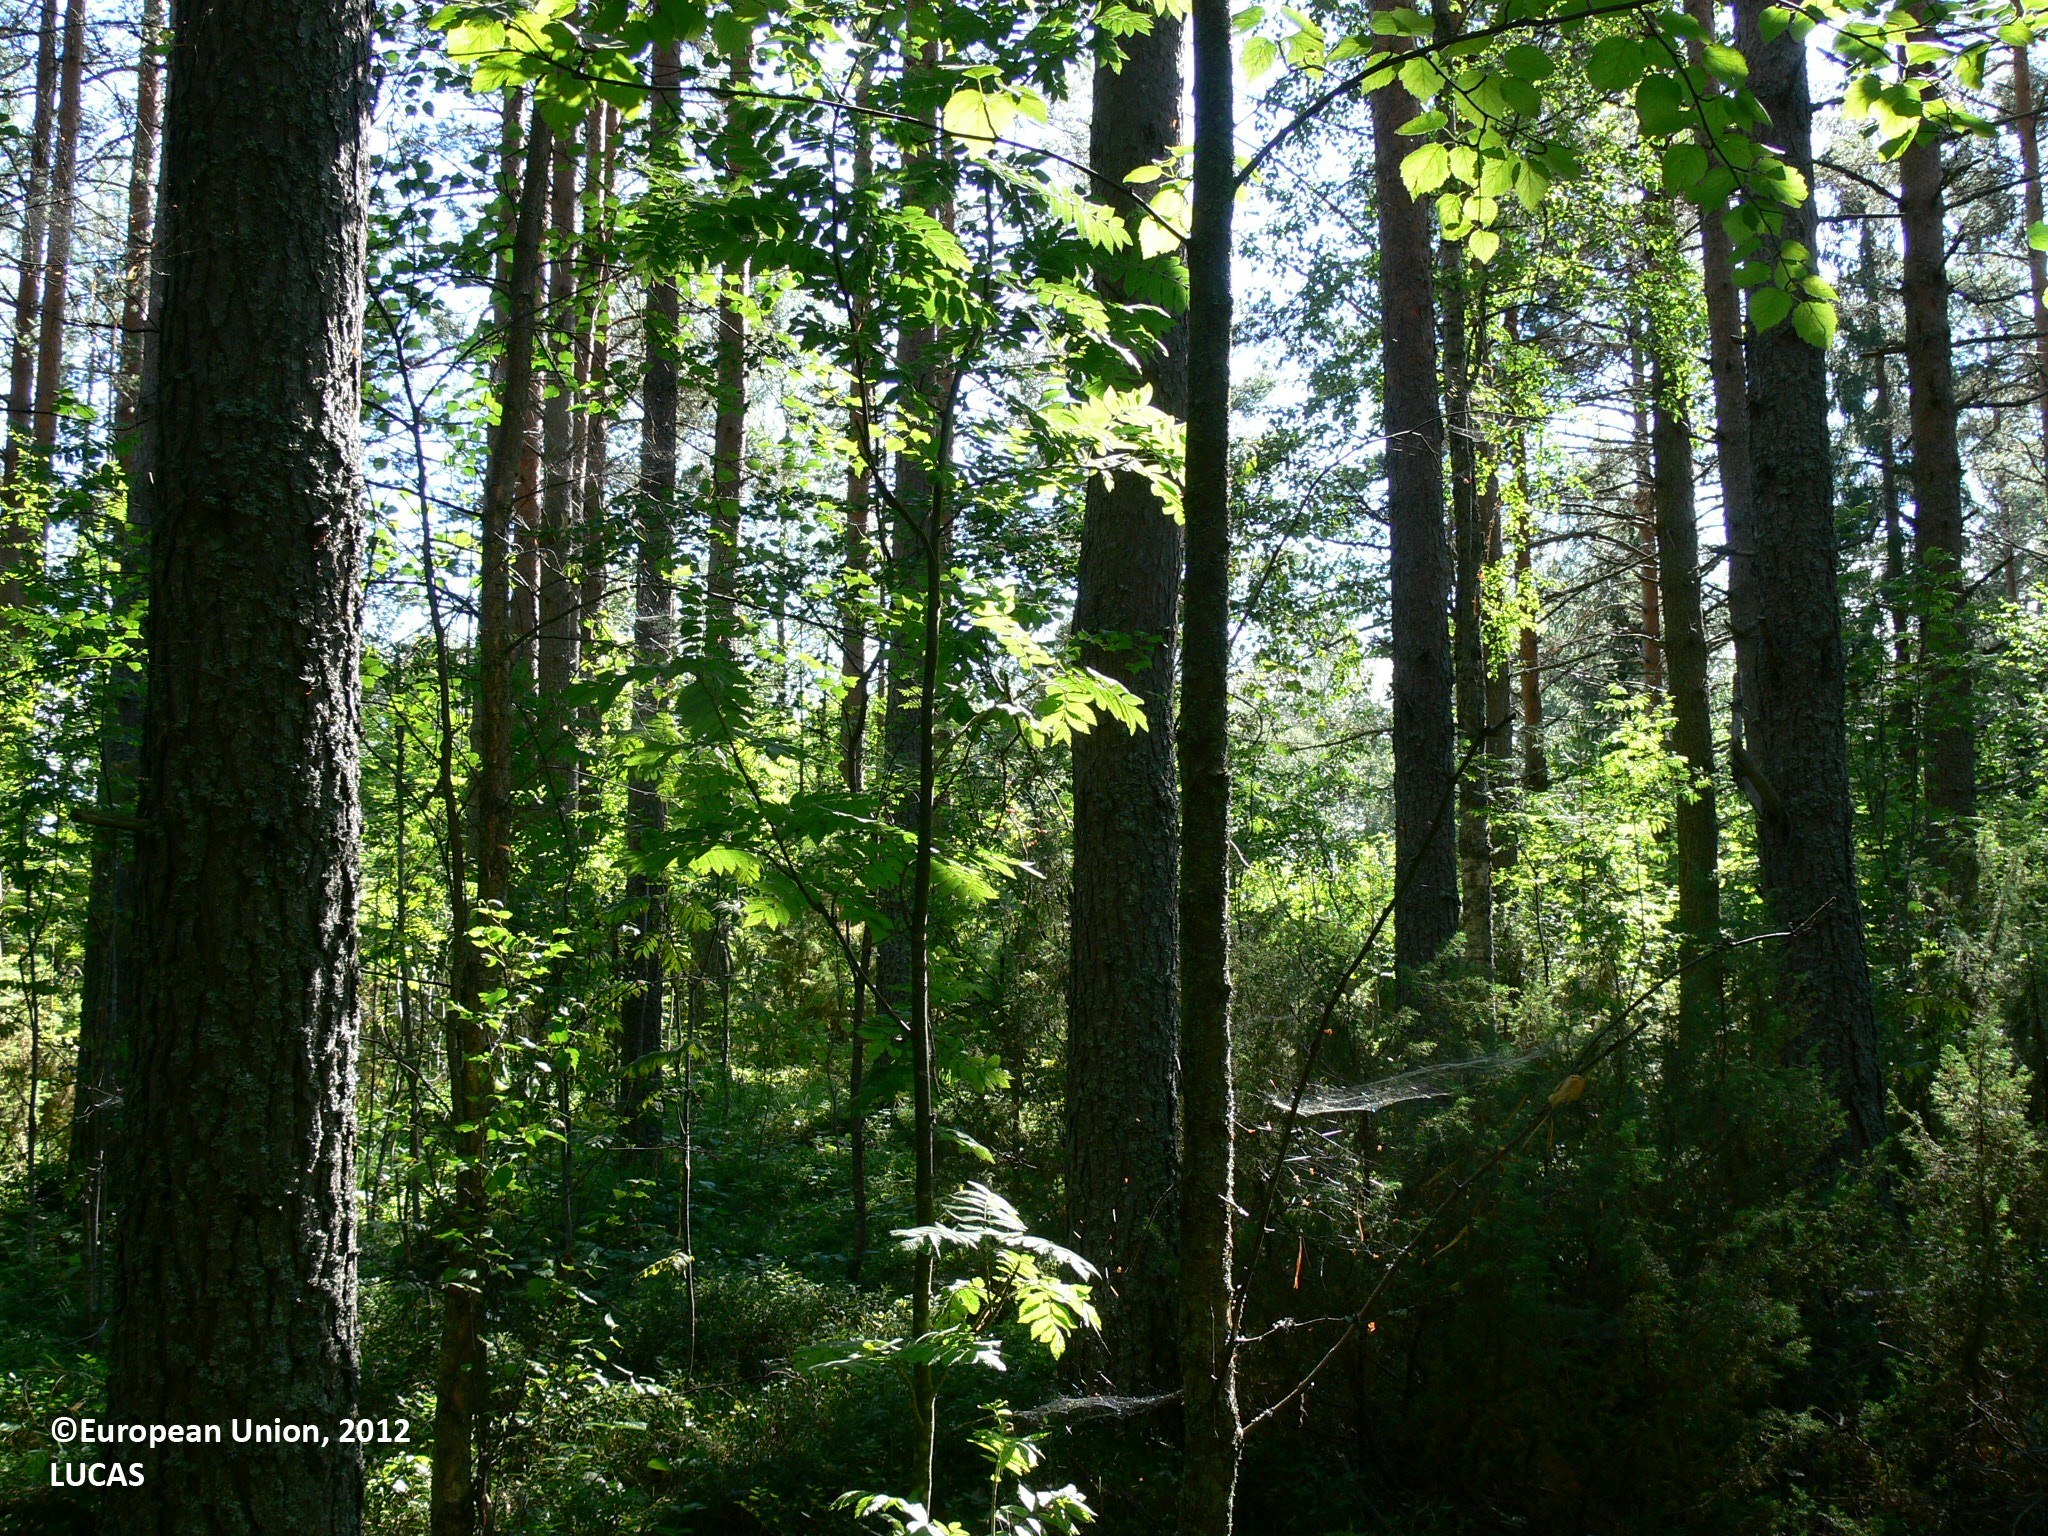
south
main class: Woodland
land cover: Pine dominated mixed woodland
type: boreal forest
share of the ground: > 75 %
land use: Forestry
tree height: > 5 m
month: July
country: FI
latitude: 63.3284
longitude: 29.4154
